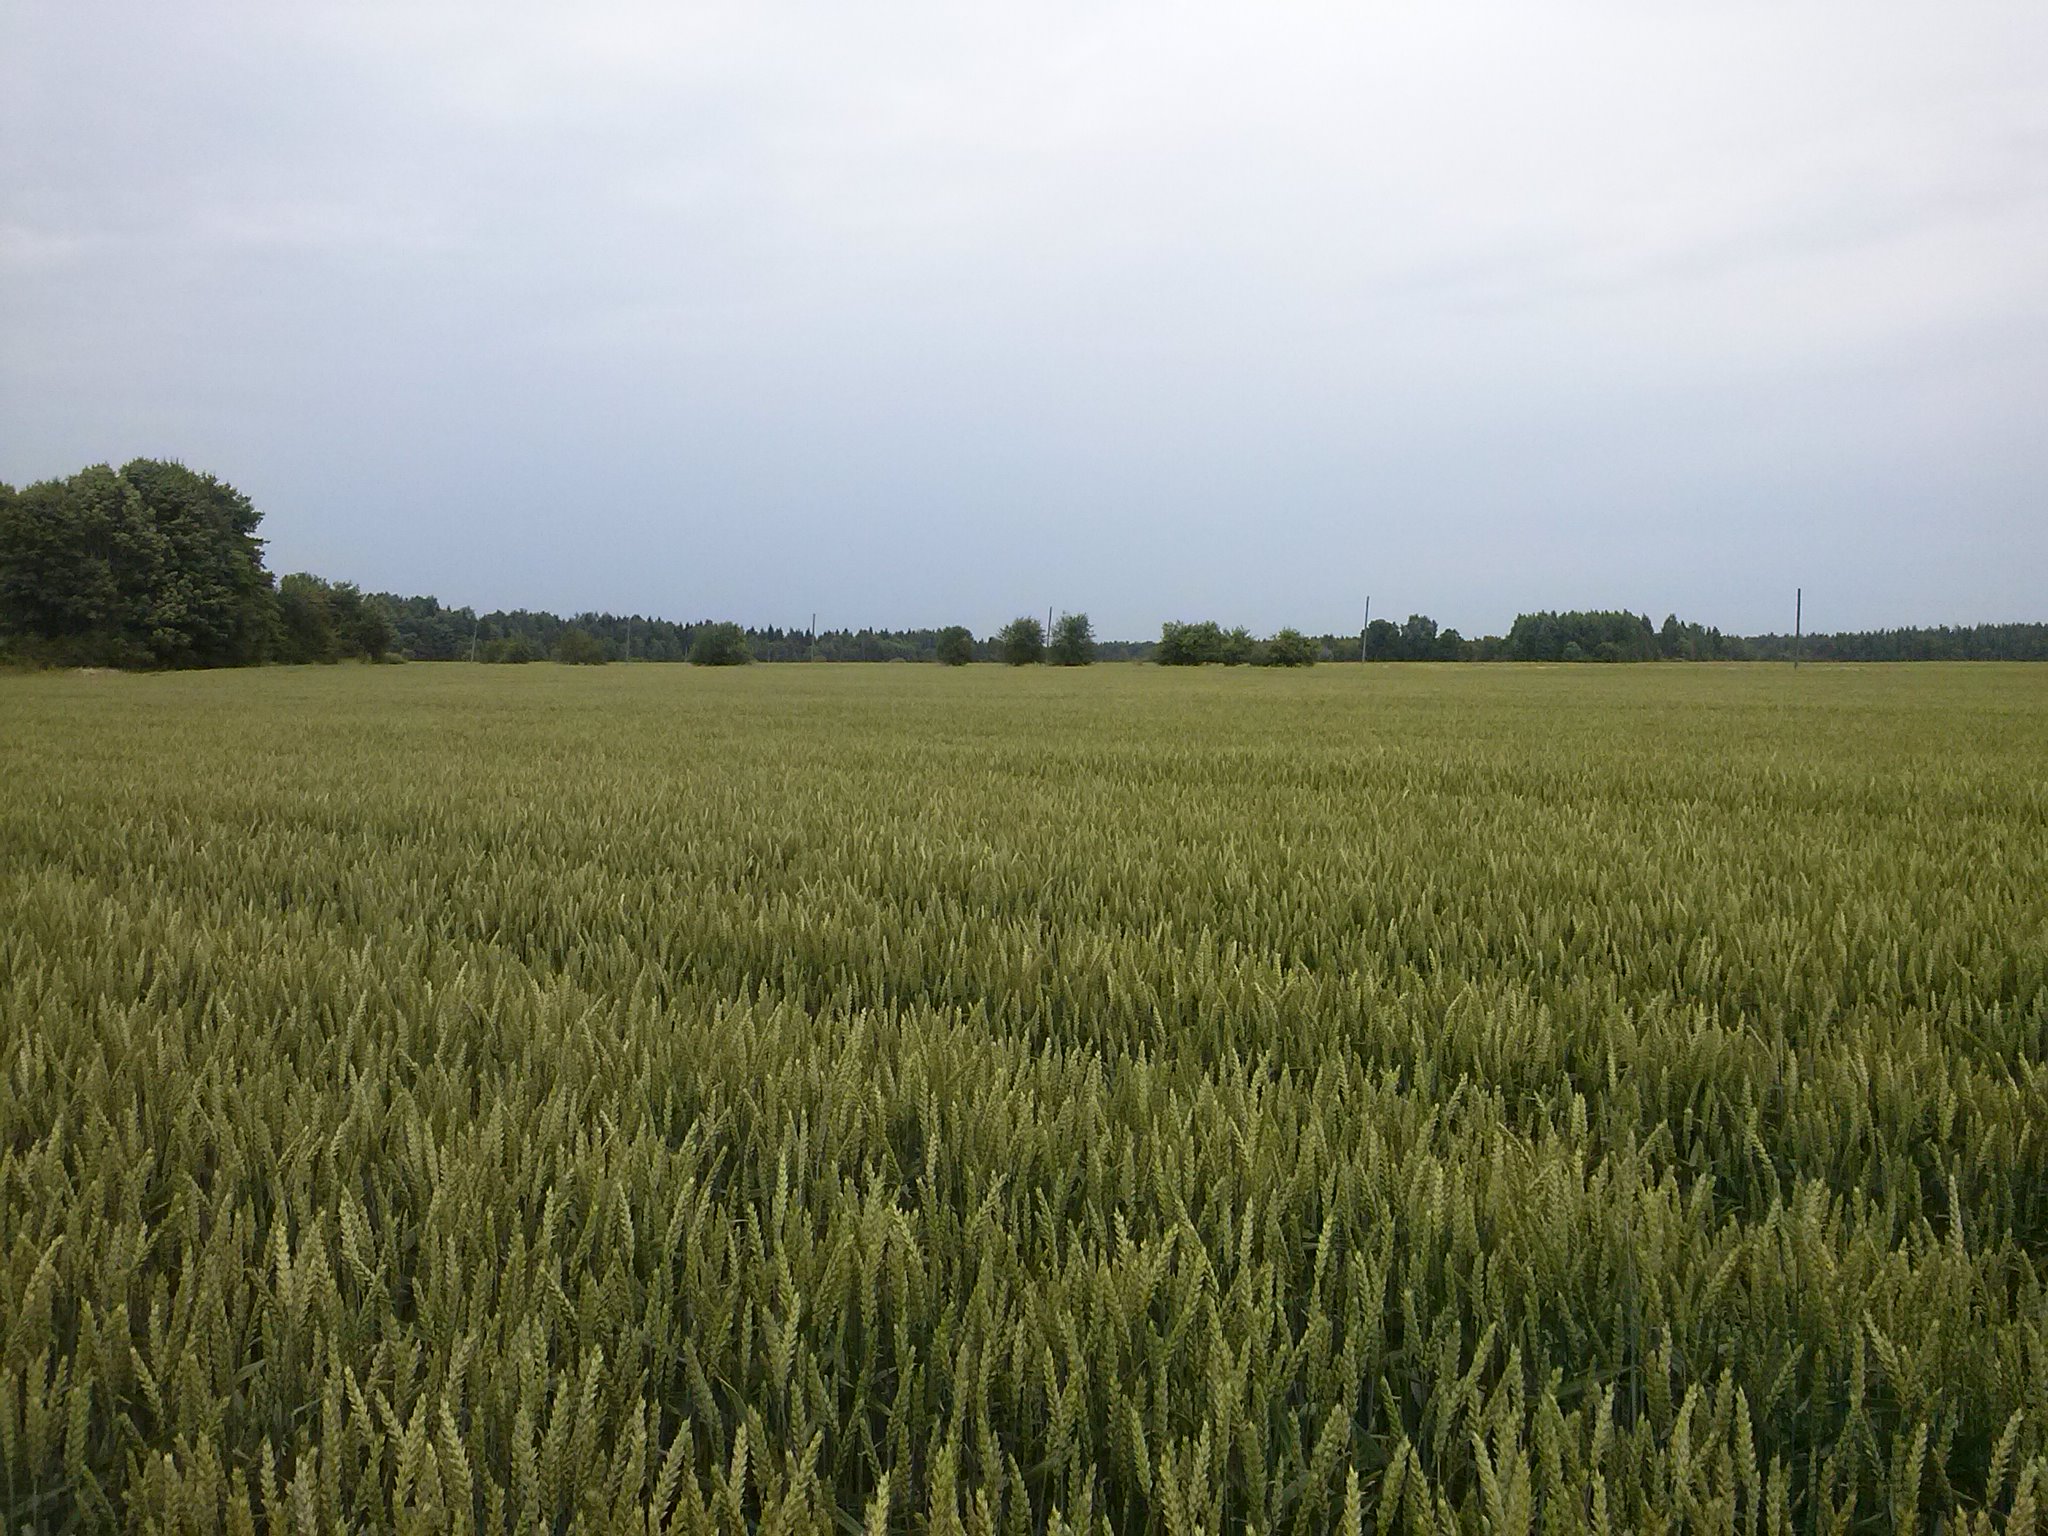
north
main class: Cropland
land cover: Common wheat
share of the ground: > 75 %
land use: Agriculture (excluding fallow land and kitchen gardens)
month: July
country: LV
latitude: 56.7871
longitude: 27.4456
